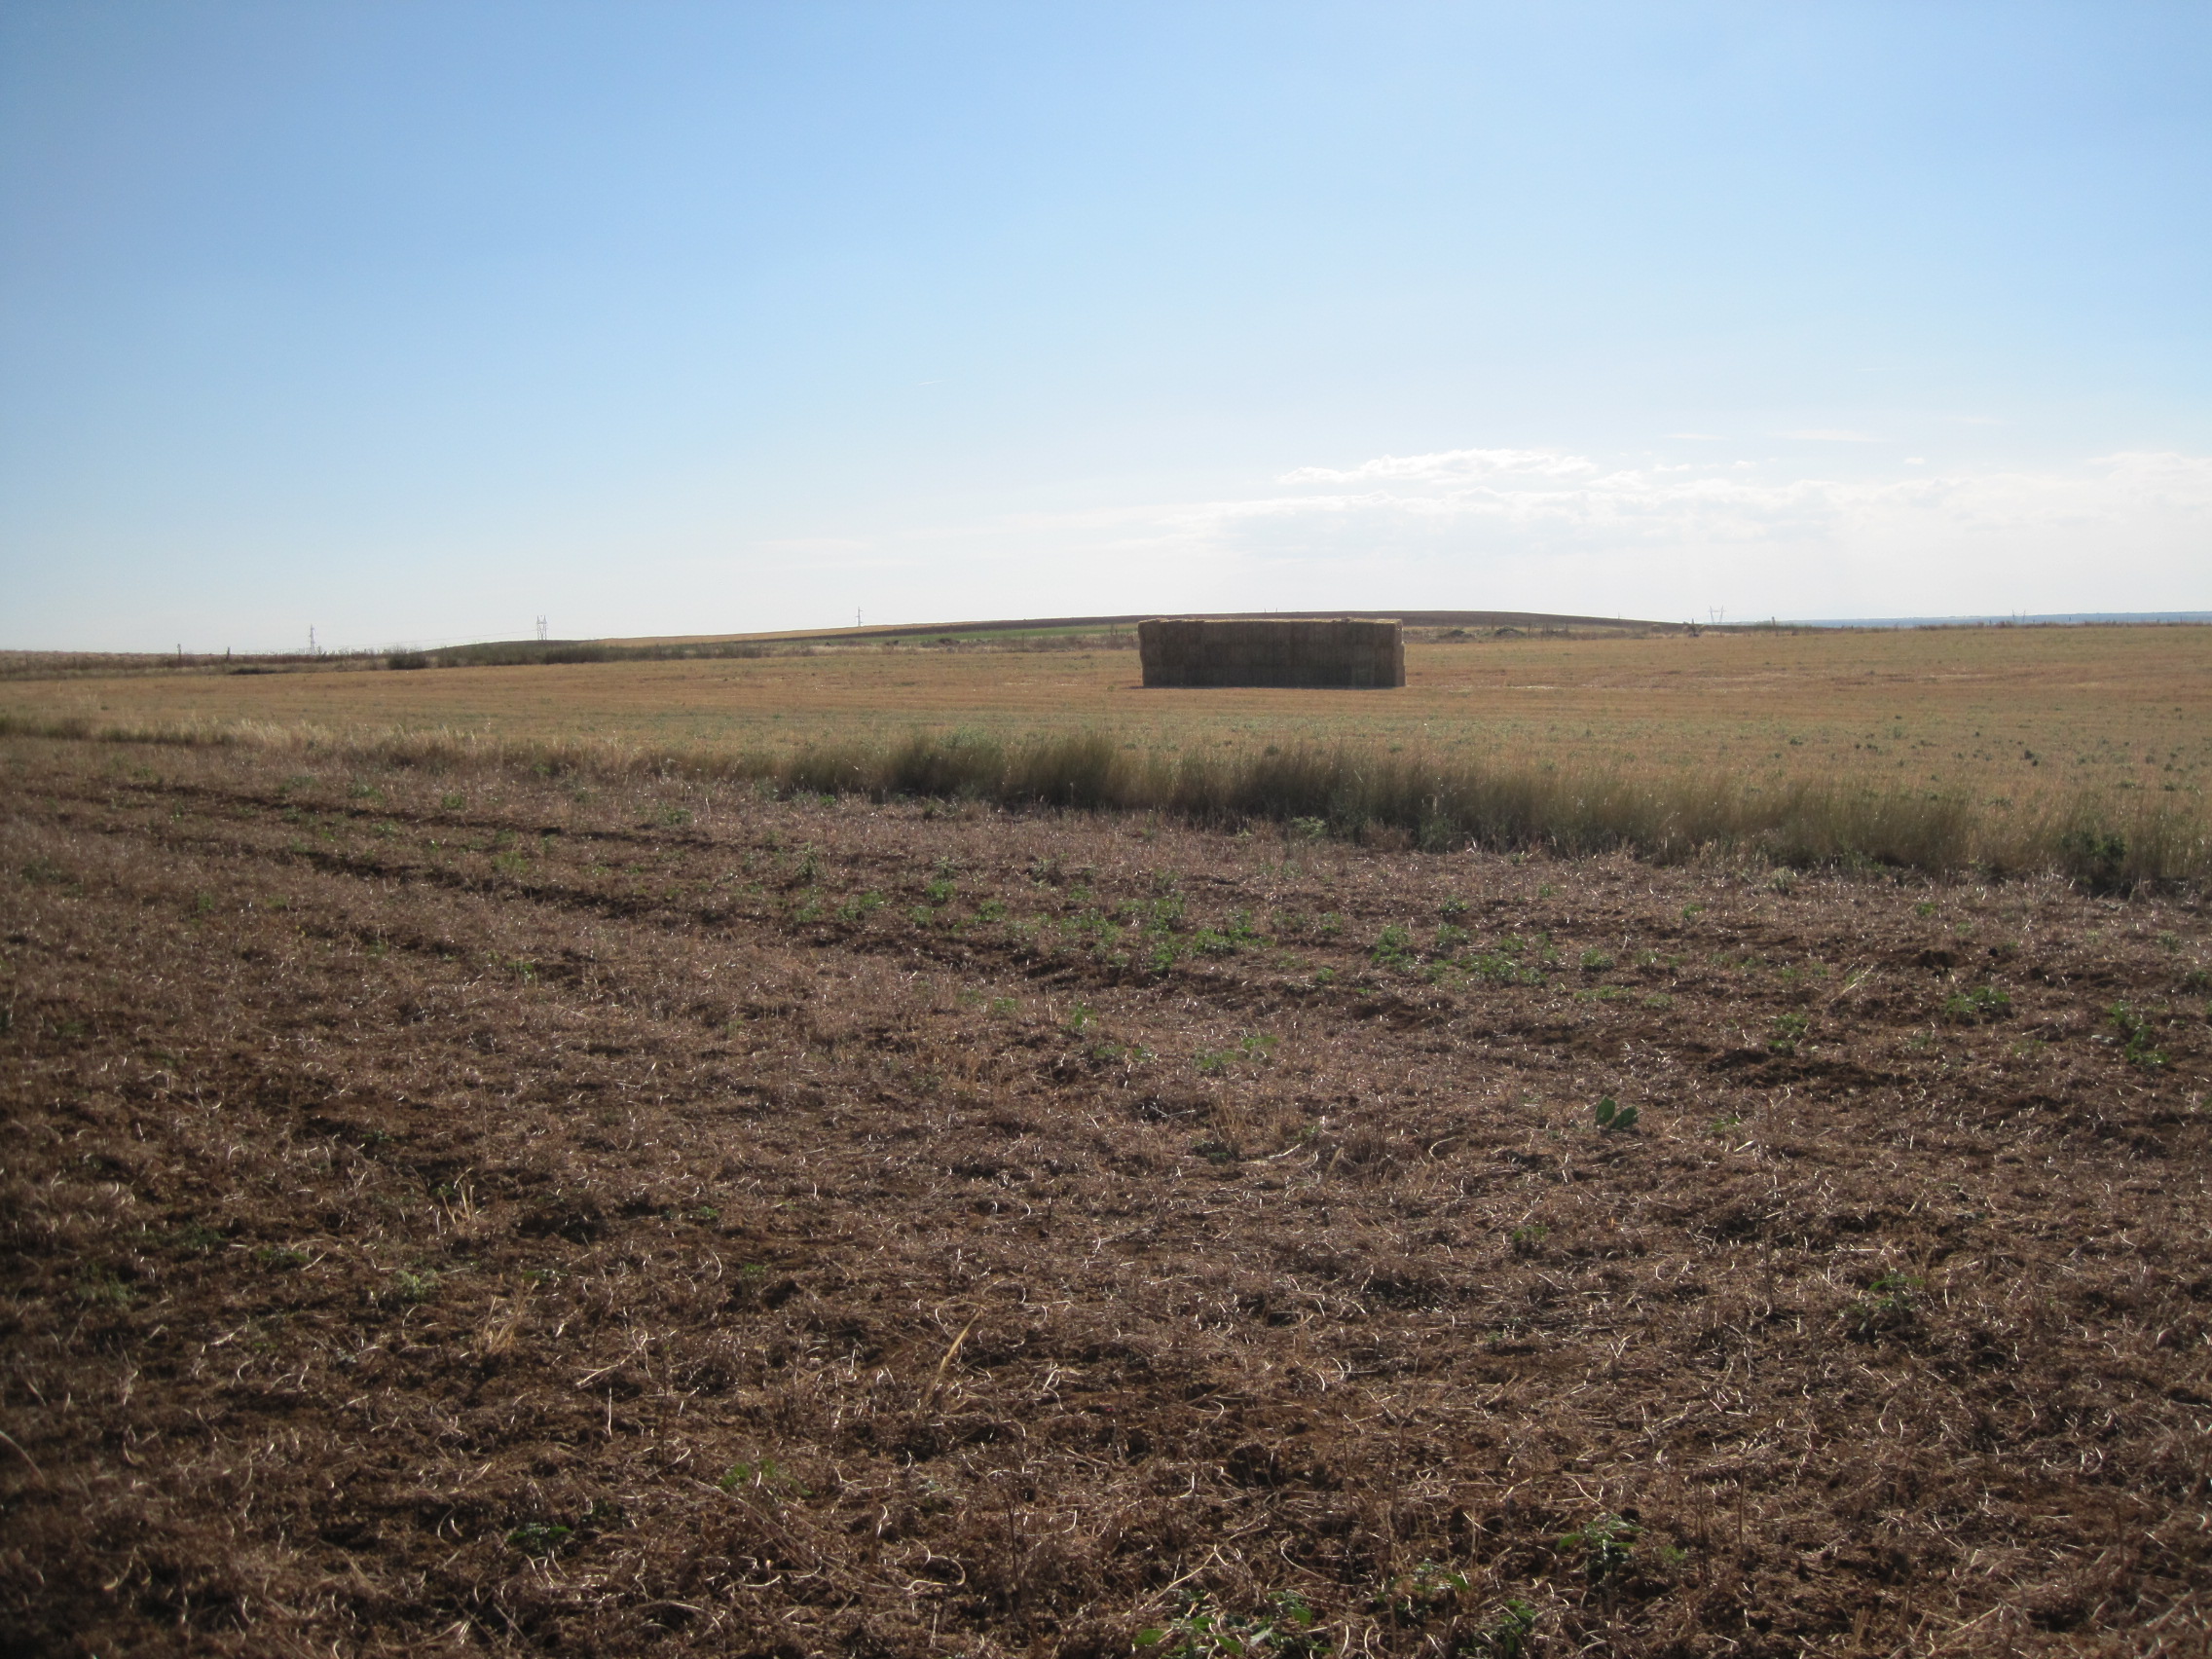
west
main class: Cropland
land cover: Dry pulses
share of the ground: < 10 %
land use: Agriculture (excluding fallow land and kitchen gardens)
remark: Harvested field
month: July
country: ES
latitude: 42.1521
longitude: -5.2485
